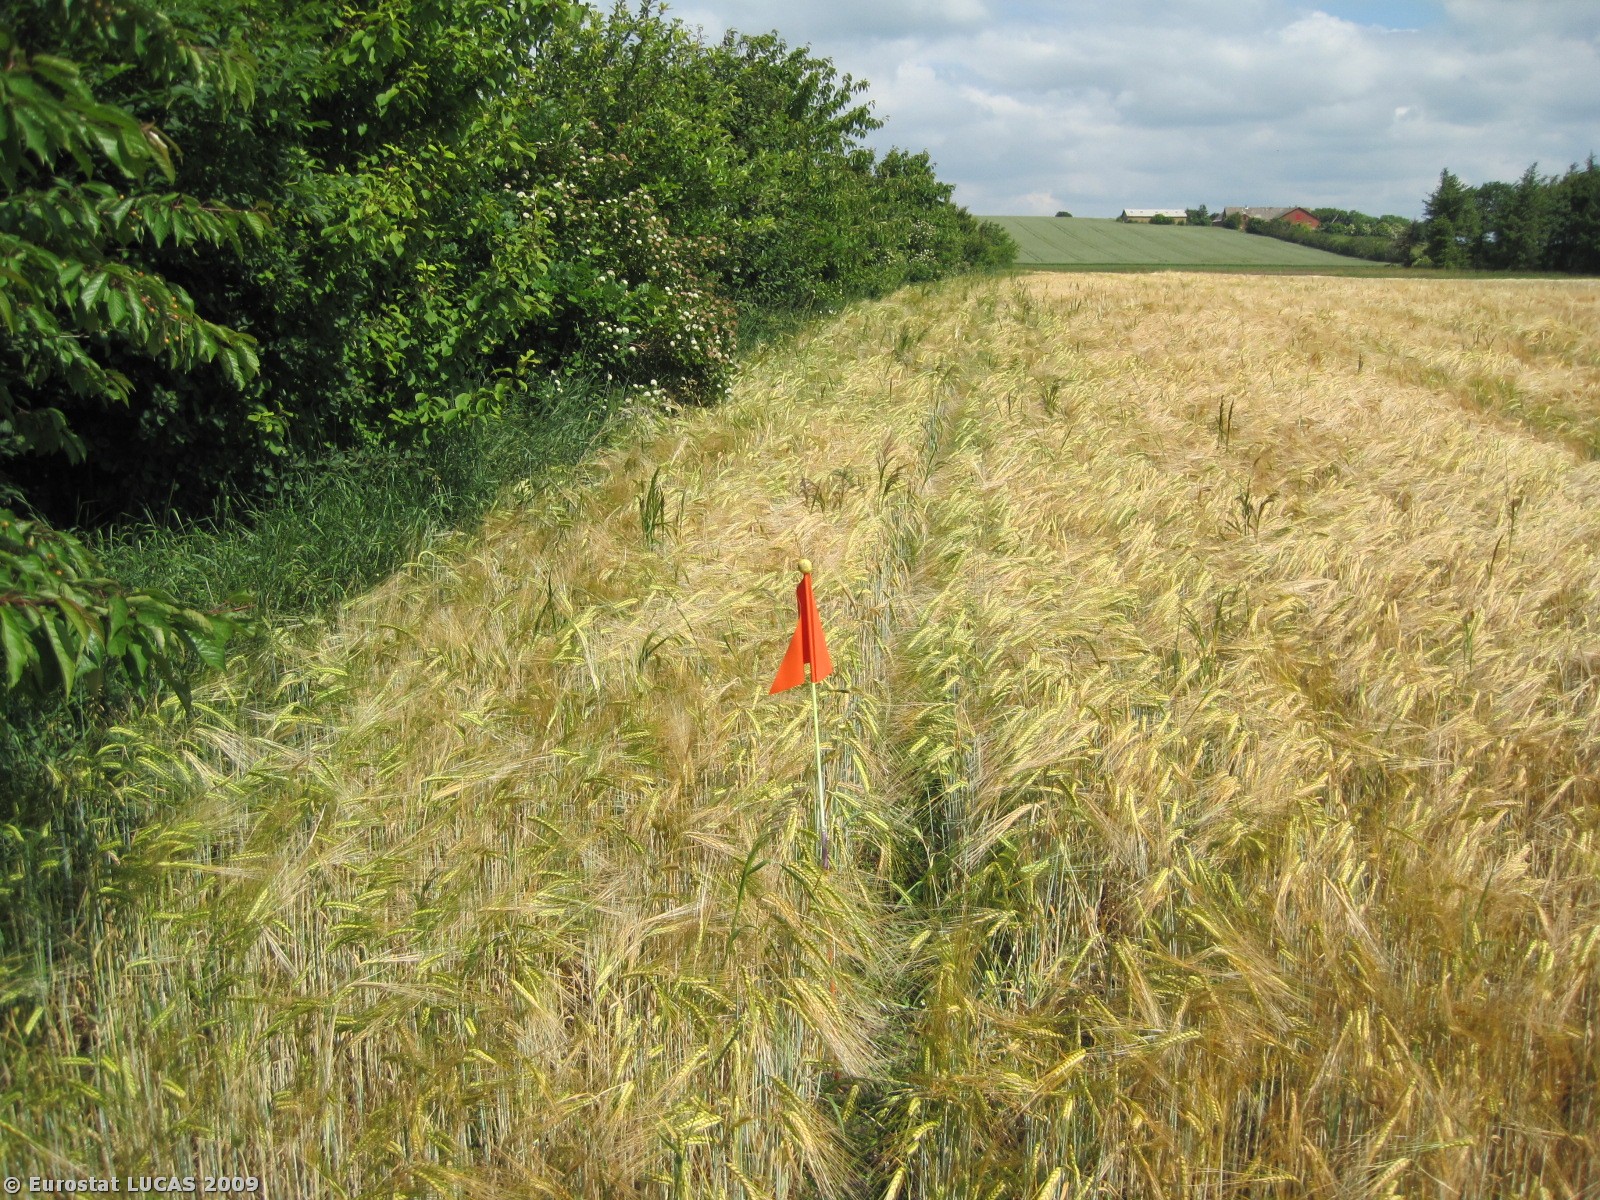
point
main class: Cropland
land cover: Barley
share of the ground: > 75 %
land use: Agriculture (excluding fallow land and kitchen gardens)
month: June
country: DK
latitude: 56.5609
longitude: 8.9437
